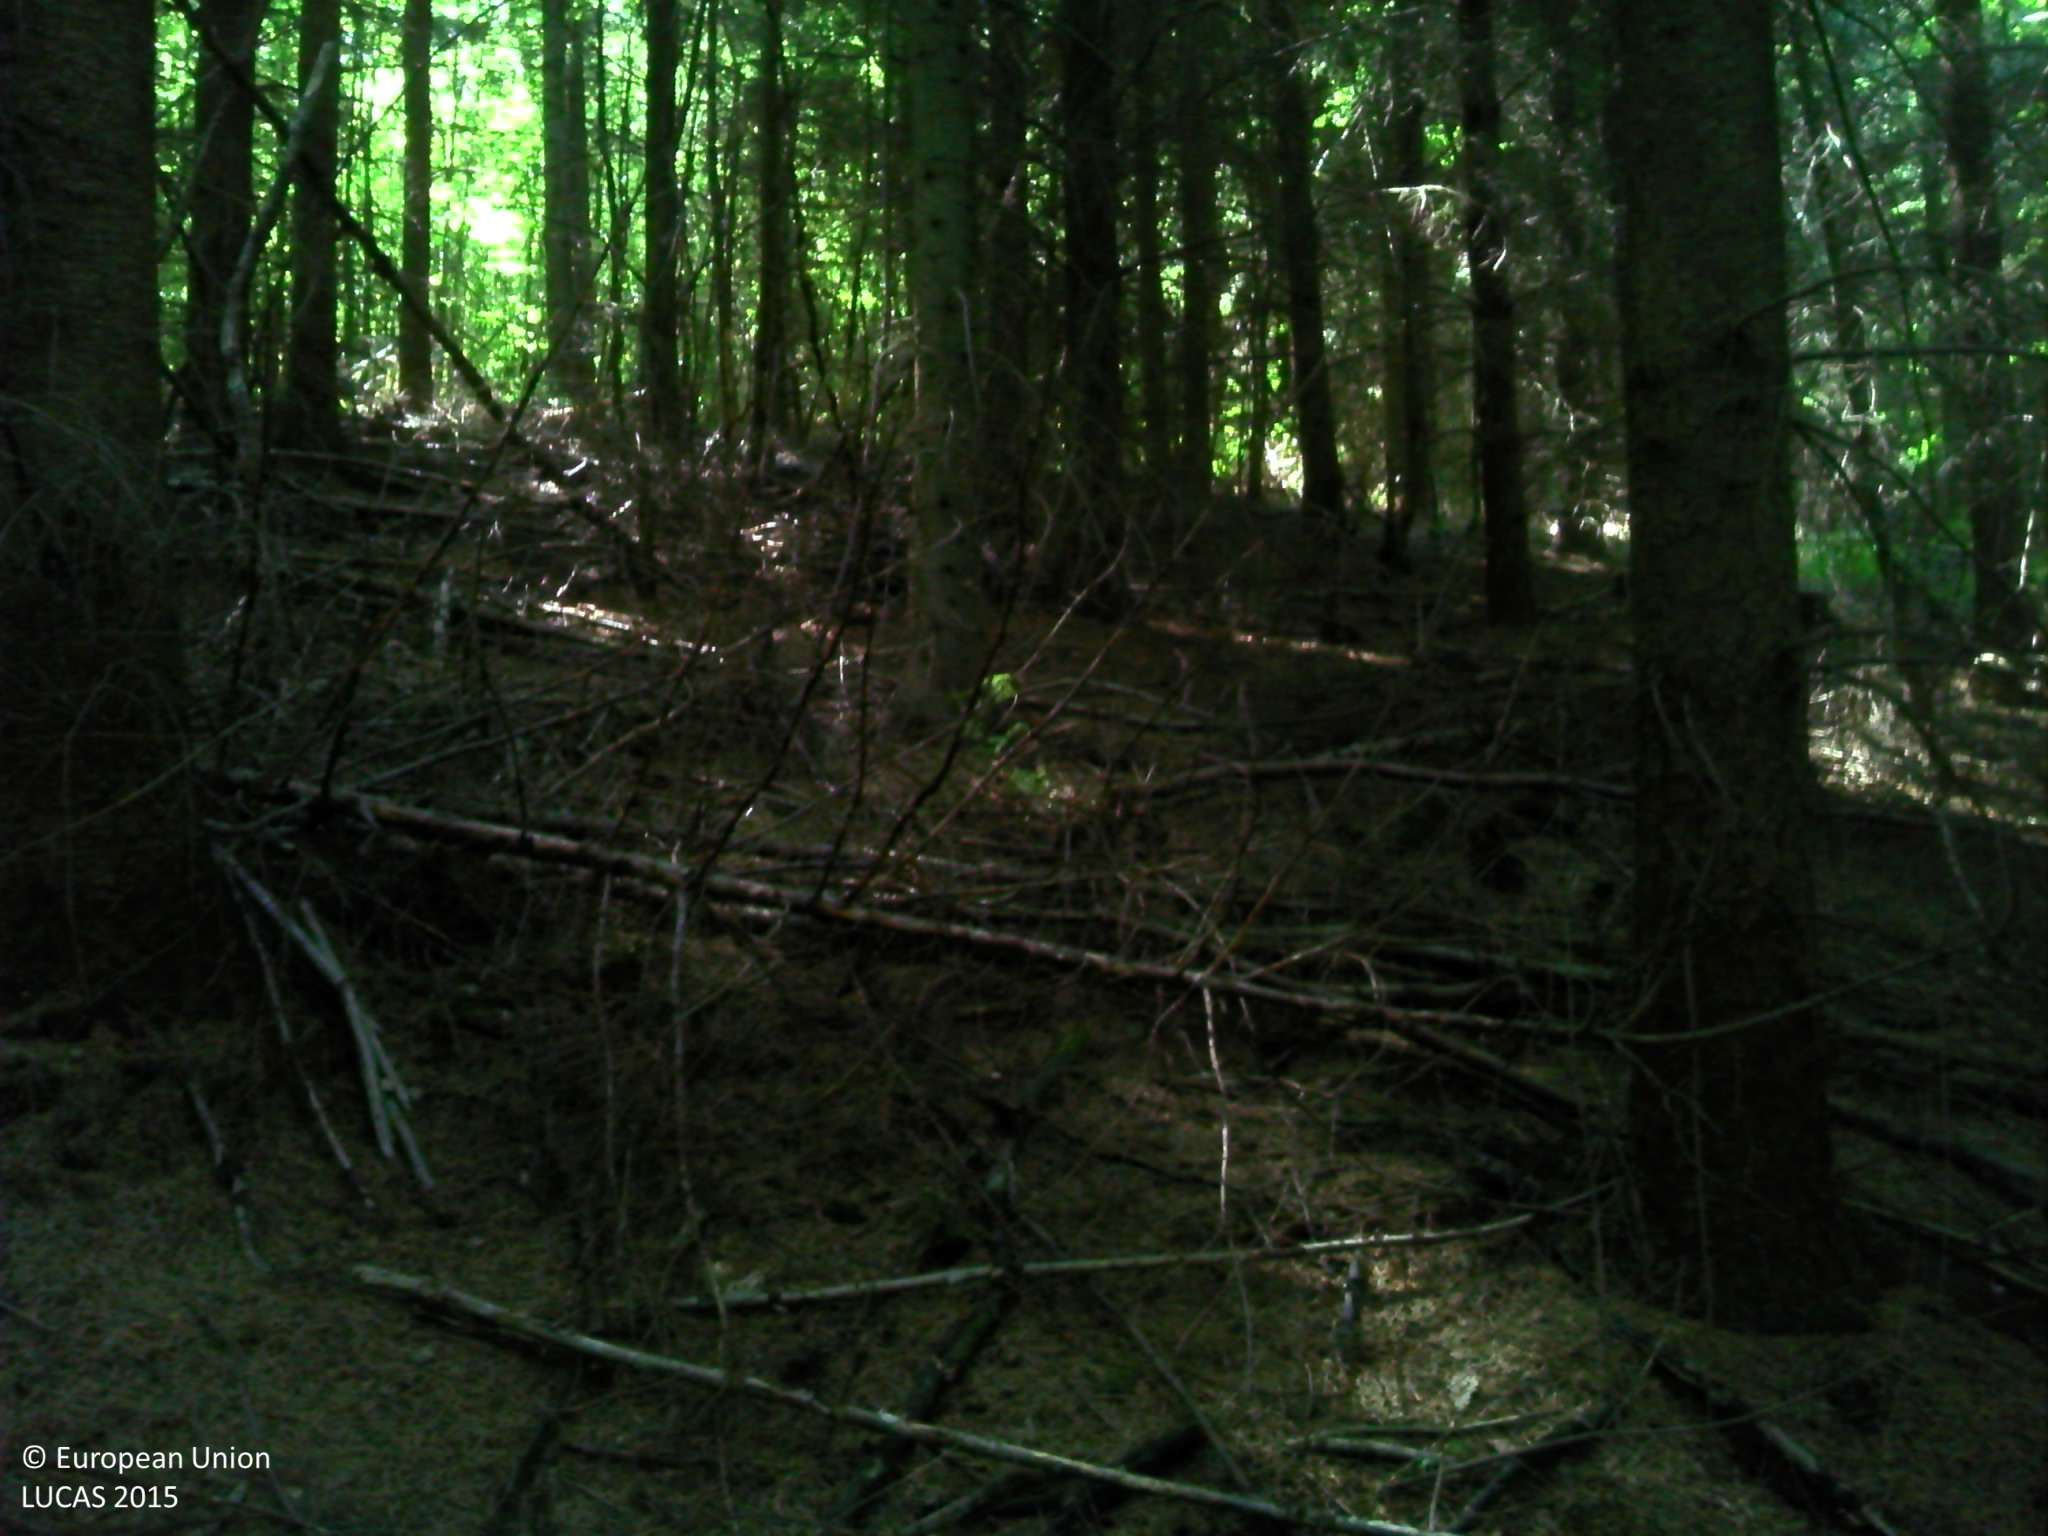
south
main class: Woodland
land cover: Spruce dominated coniferous woodland
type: hemiboreal forest and nemoral coniferous forest and mixed broadleaved-coniferous forest
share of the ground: > 75 %
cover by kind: coniferous forest trees 80 %, herbaceous plants 20 %
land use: Forestry
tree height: > 5 m
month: August
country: FR
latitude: 45.7078
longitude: 4.5699
